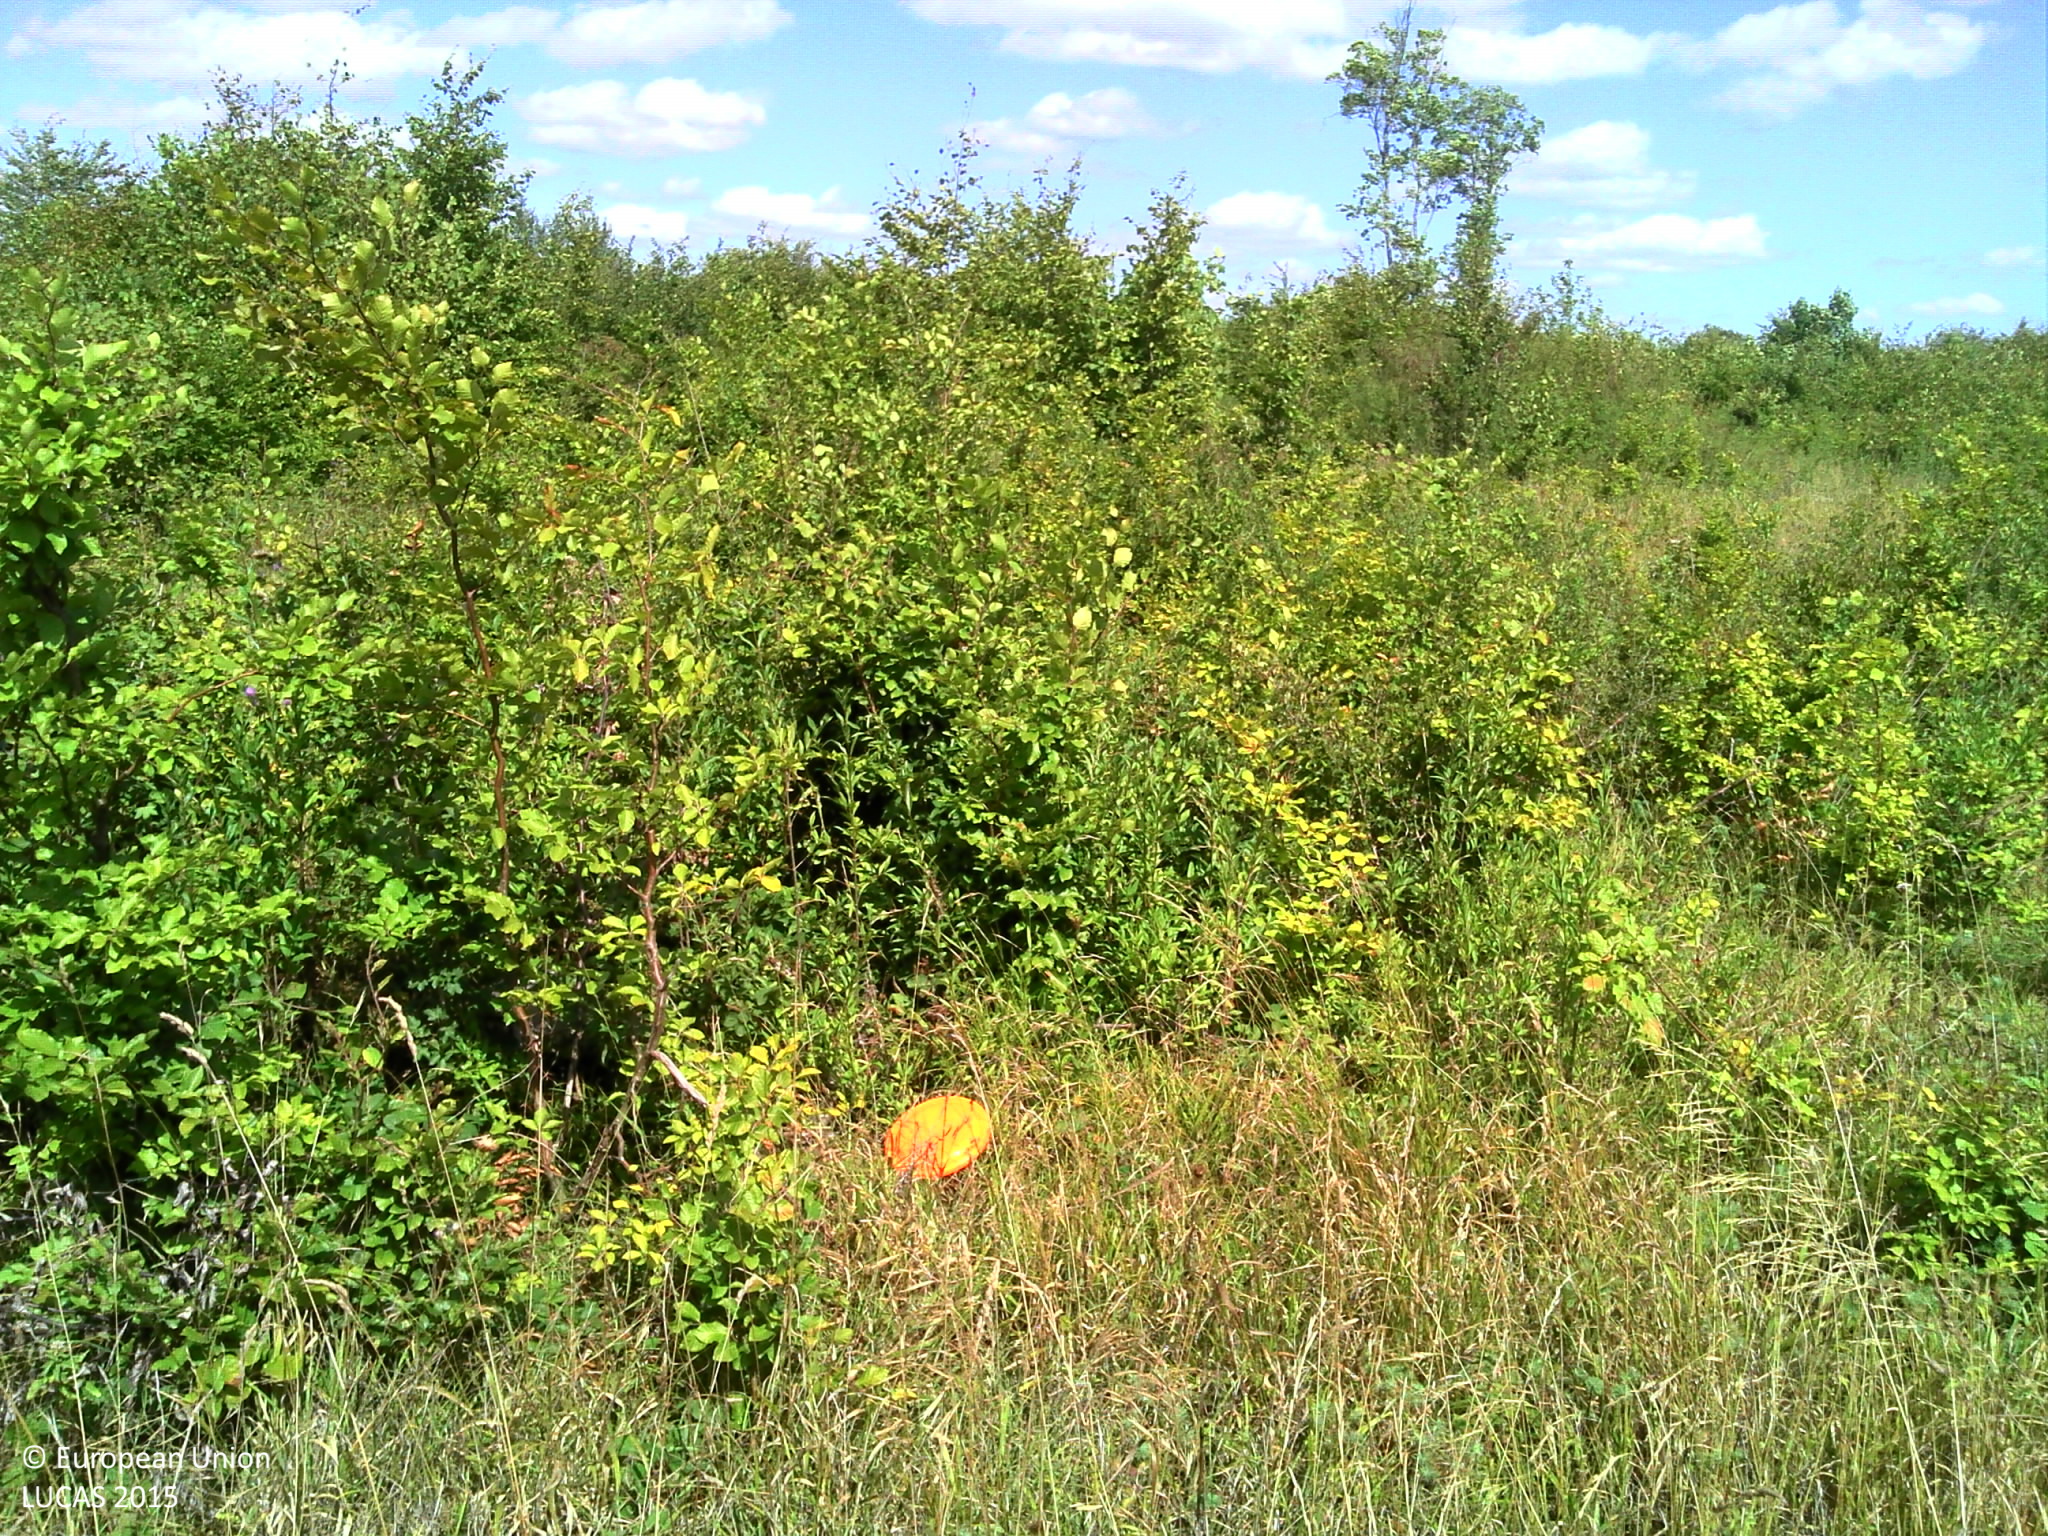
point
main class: Woodland
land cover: Broadleaved woodland
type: mesophytic deciduous forest
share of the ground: > 75 %
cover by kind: broadleaved forest trees 90 %, herbaceous plants 5 %, lichens and mosses 5 %
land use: Forestry
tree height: < 5 m
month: August
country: FR
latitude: 47.8317
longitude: 4.8291
